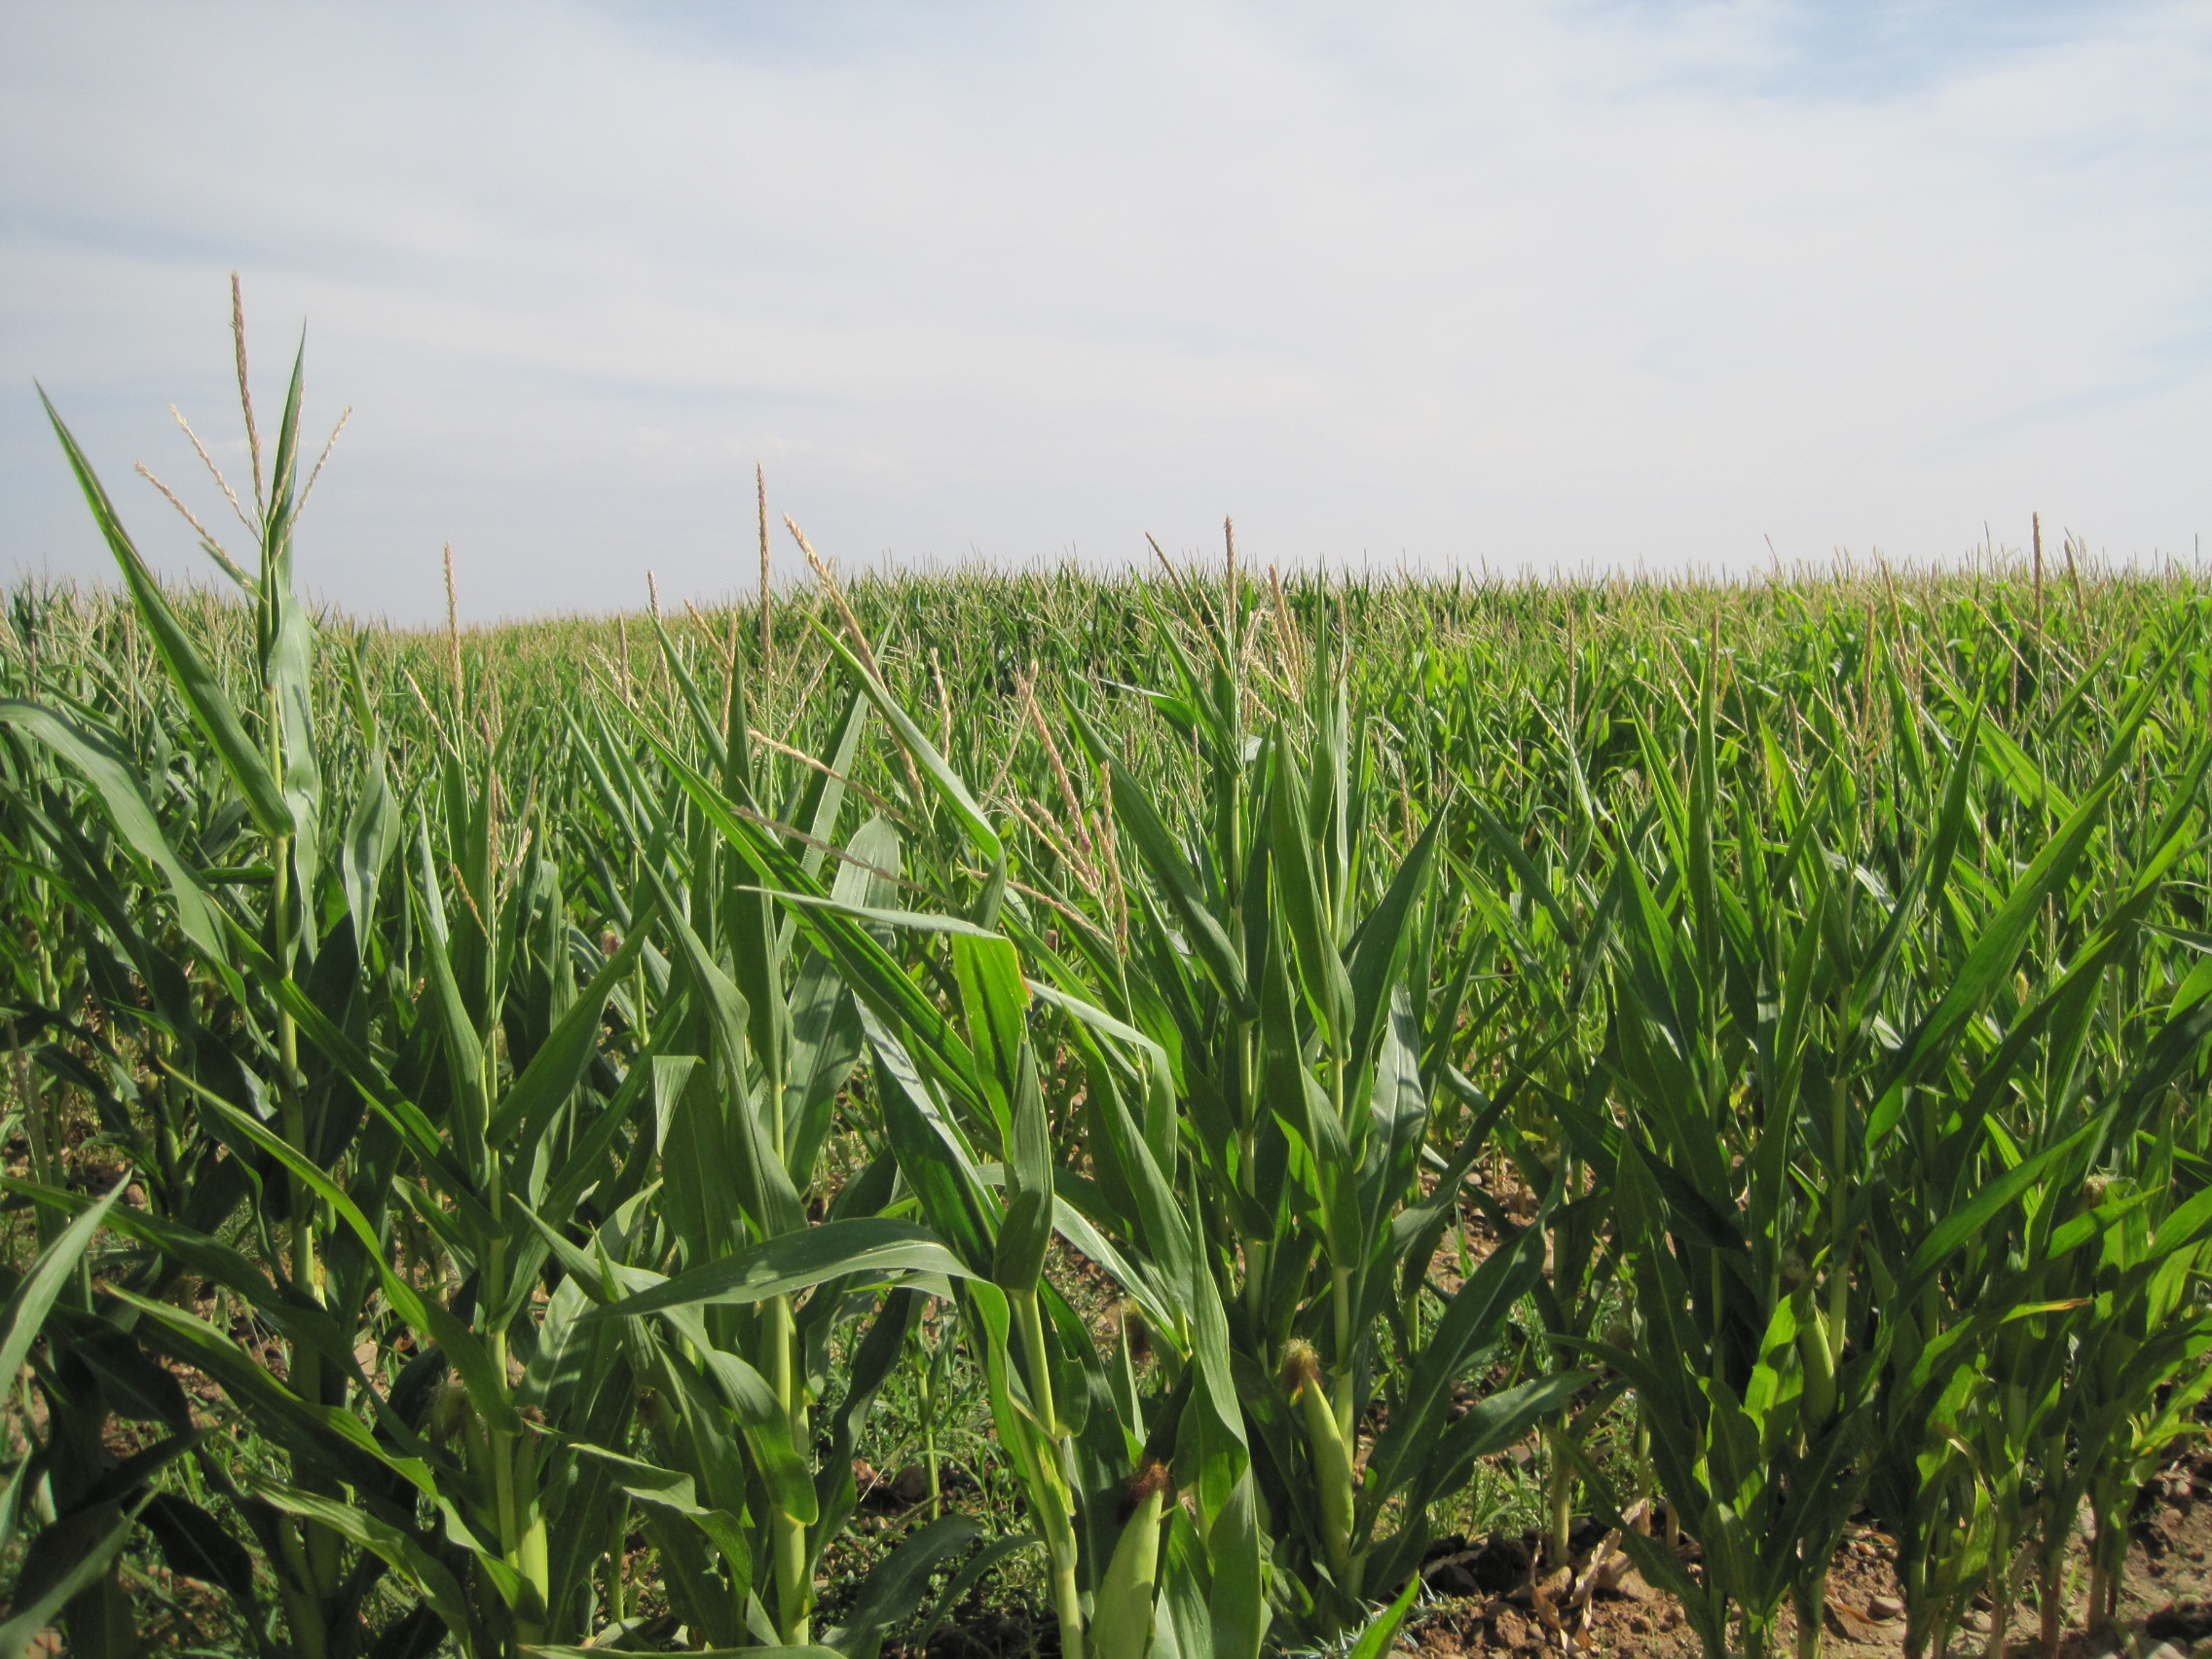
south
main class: Cropland
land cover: Common wheat
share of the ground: < 10 %
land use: Agriculture (excluding fallow land and kitchen gardens)
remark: Harvested field
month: July
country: ES
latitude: 41.7228
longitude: -5.5318
